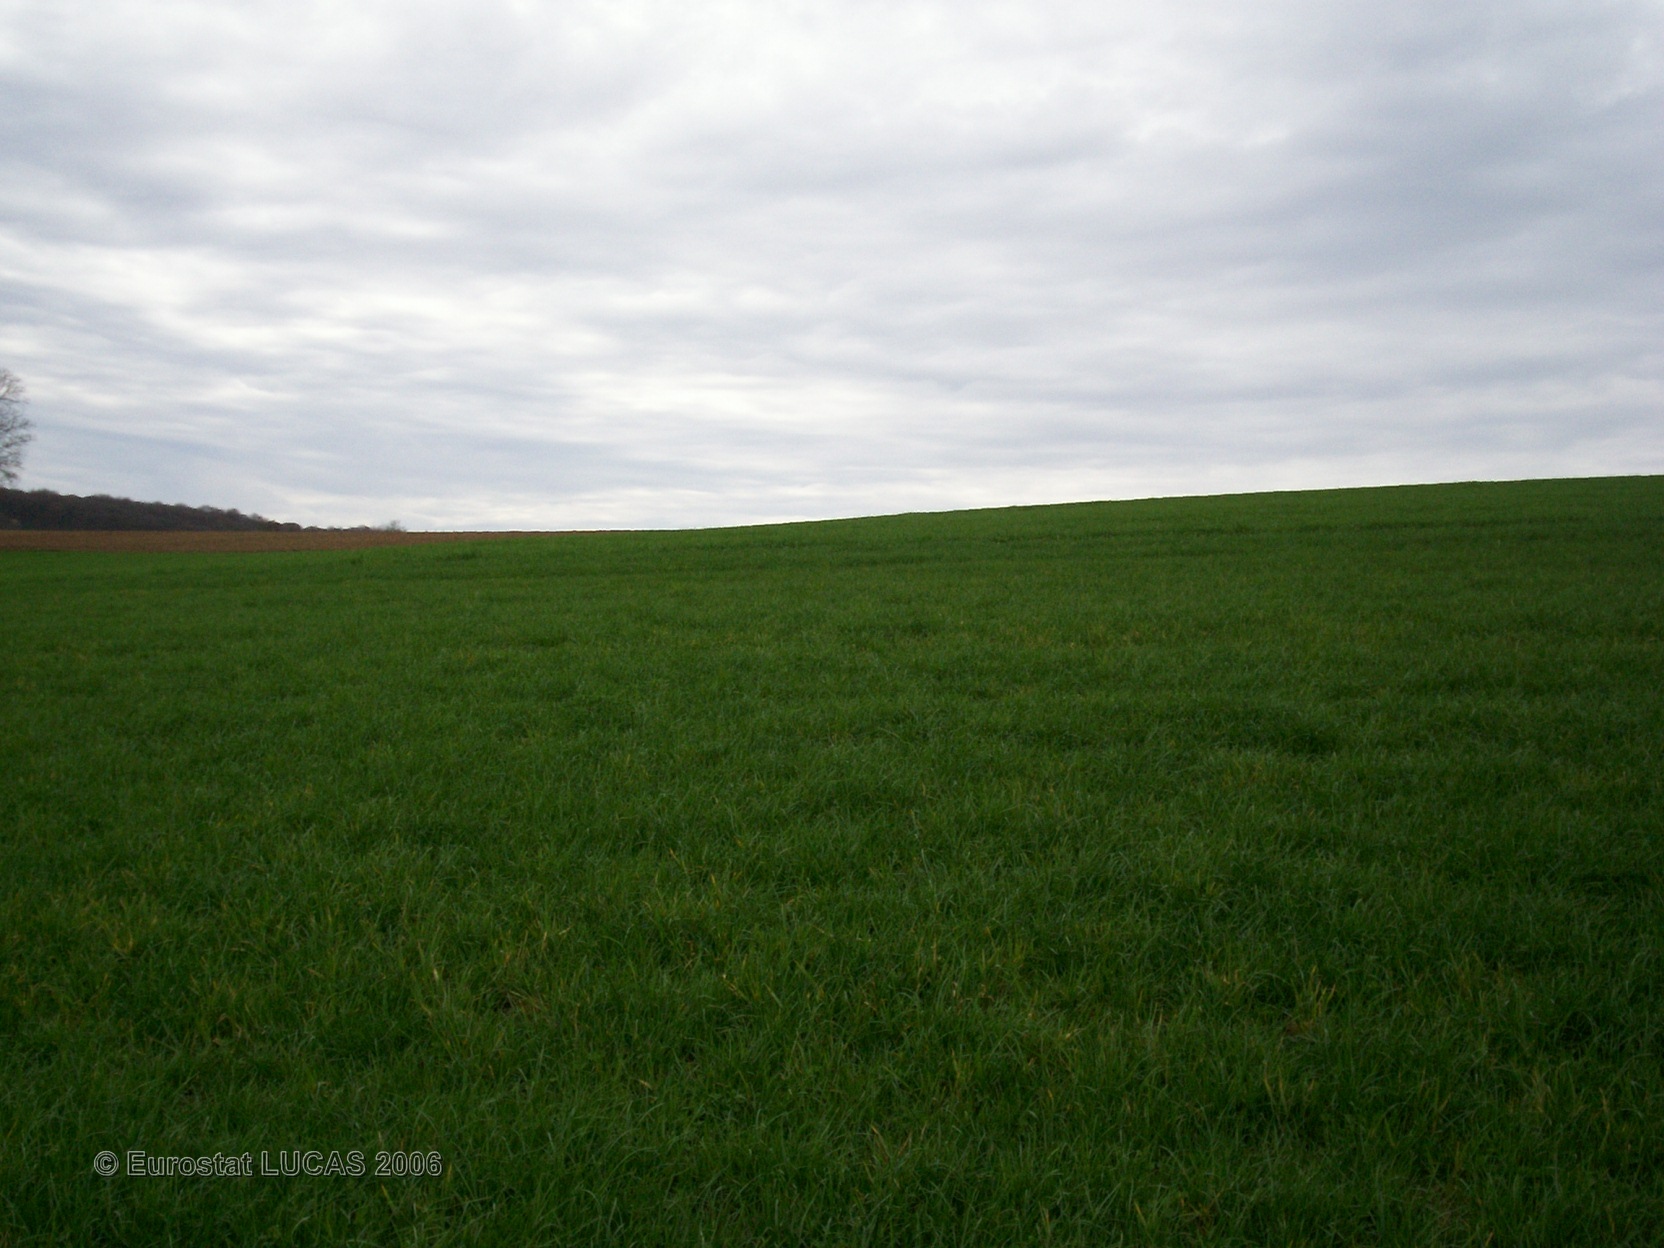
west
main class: Cropland
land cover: Other leguminous and mixtures for fodder
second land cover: Clovers
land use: Agriculture (excluding fallow land and kitchen gardens)
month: April
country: FR
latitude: 48.2571
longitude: 5.9459
